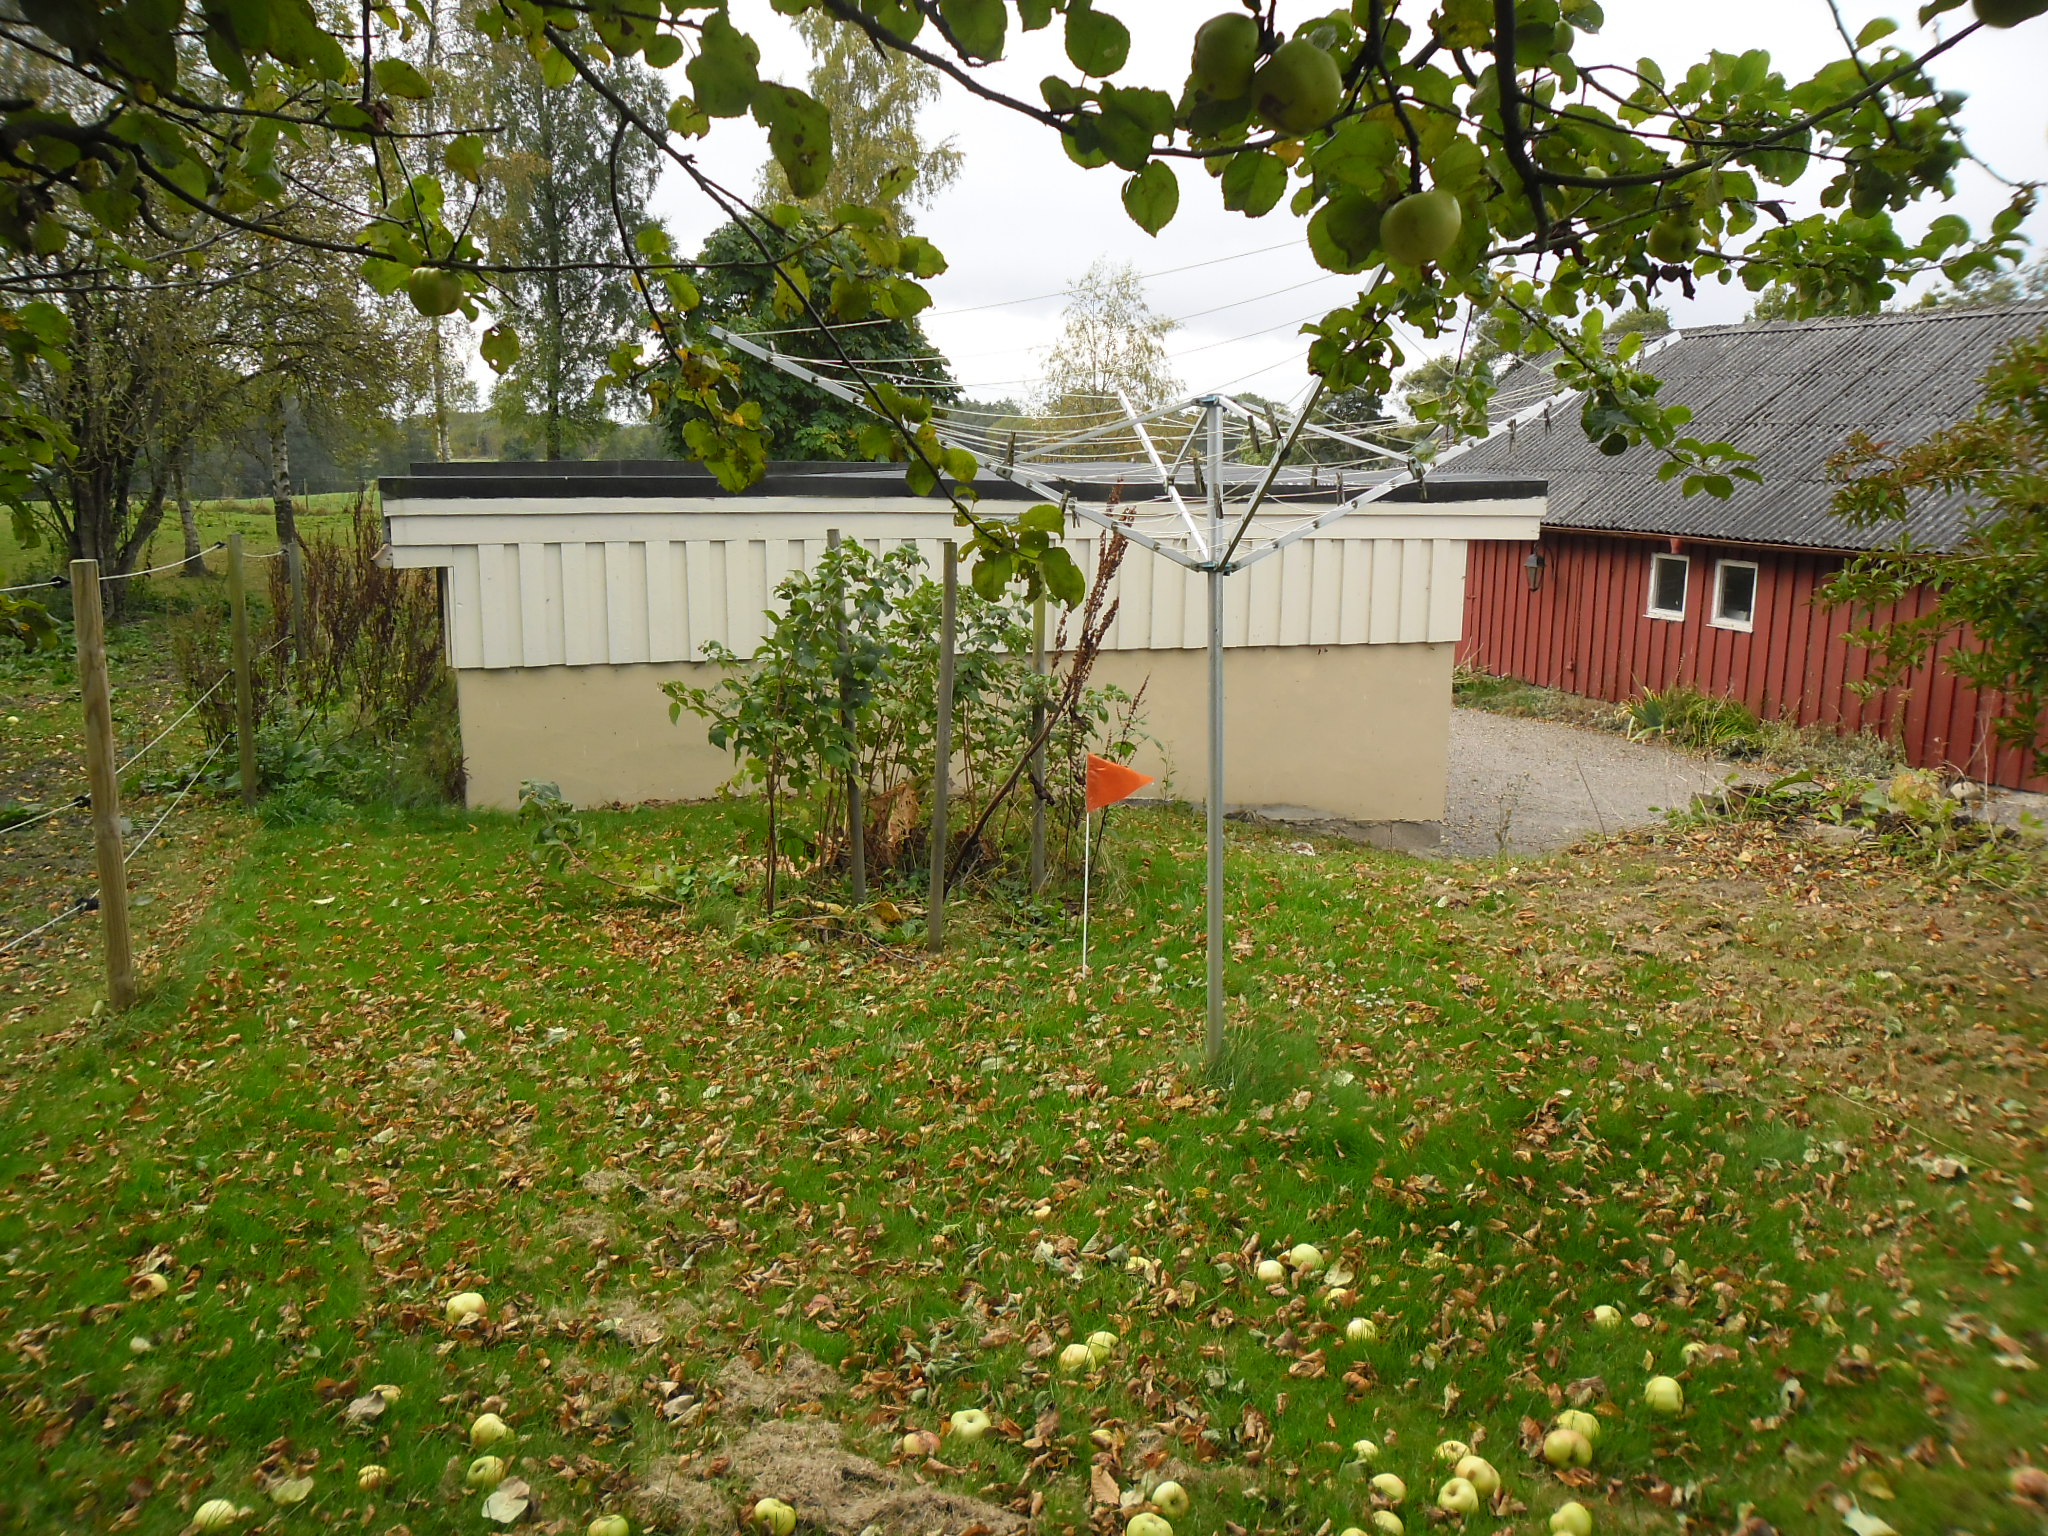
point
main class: Grassland
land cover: Grassland with sparse tree/shrub cover
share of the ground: > 75 %
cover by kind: herbaceous plants 95 %, broadleaved forest trees 5 %
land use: Residential
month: October
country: SE
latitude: 56.4914
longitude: 13.1317
